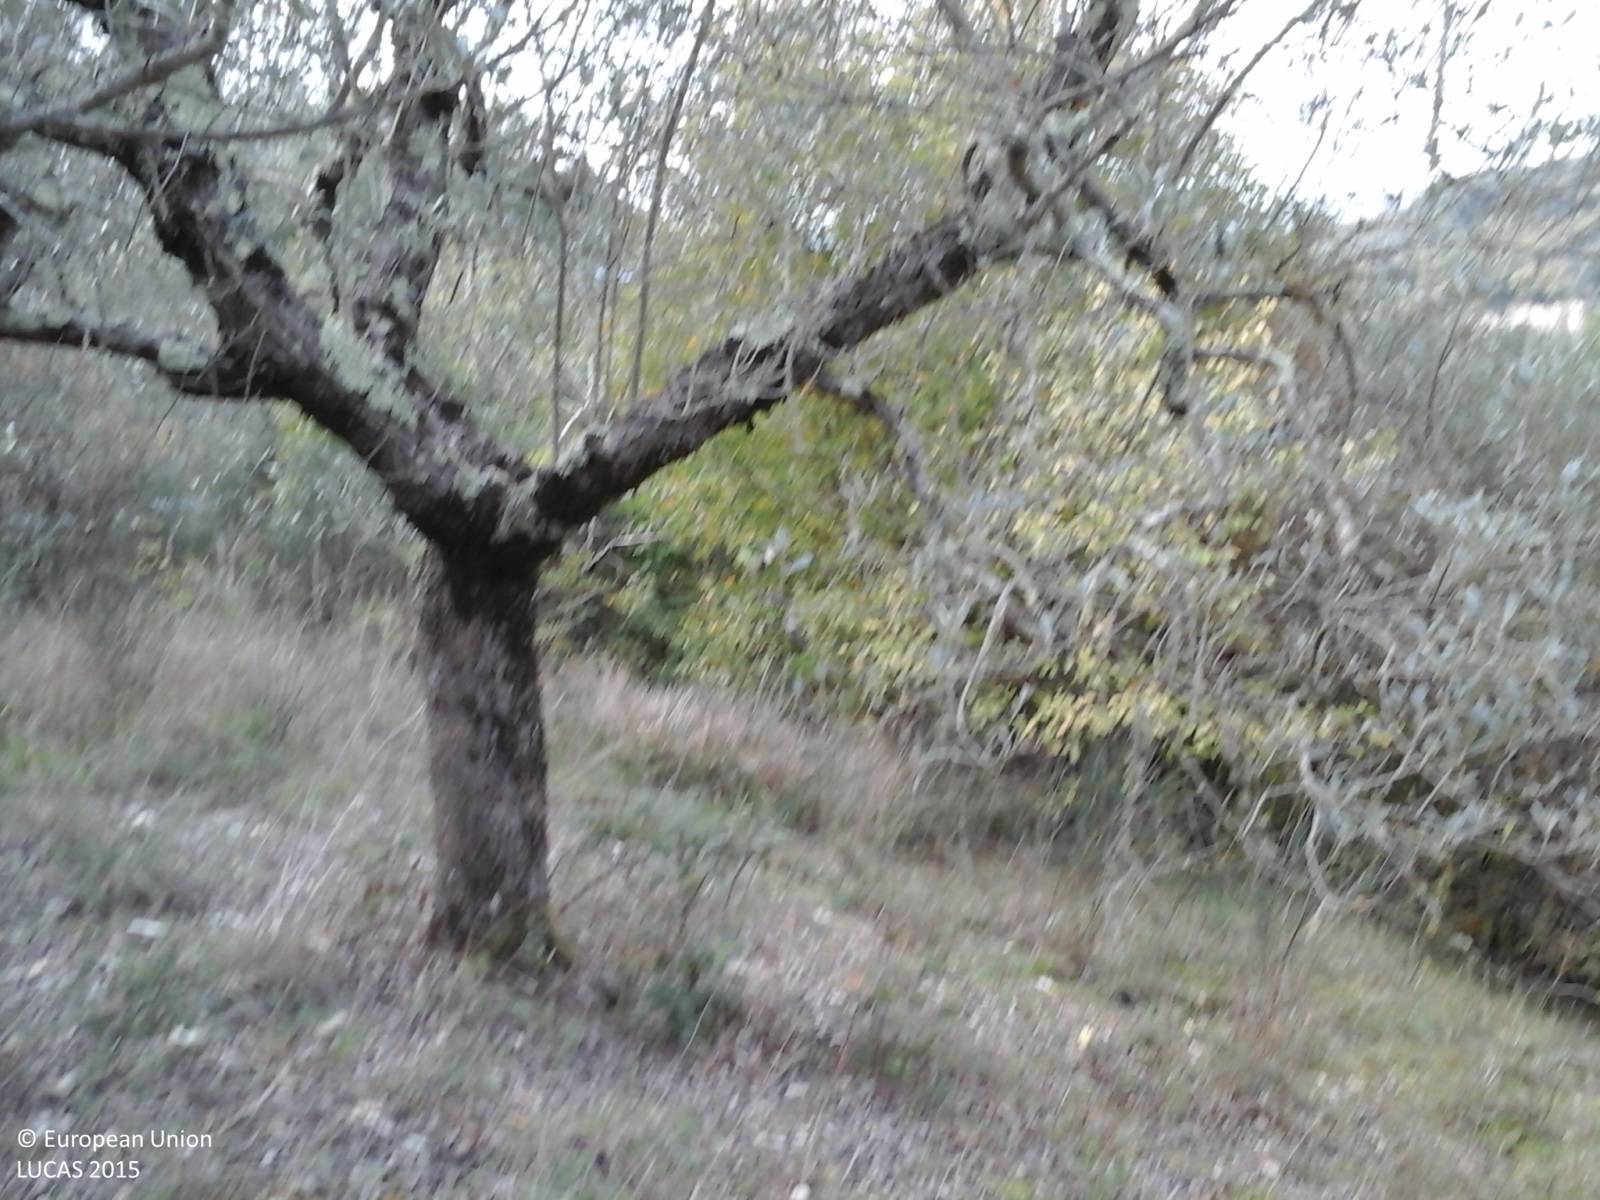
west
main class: Woodland
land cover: Broadleaved woodland
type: thermophilous deciduous forest
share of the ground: > 75 %
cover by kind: broadleaved forest trees 75 %, shrubs 20 %, herbaceous plants 5 %
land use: Semi-natural and natural areas not in use
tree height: > 5 m
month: October
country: IT
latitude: 42.7188
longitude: 12.2763
